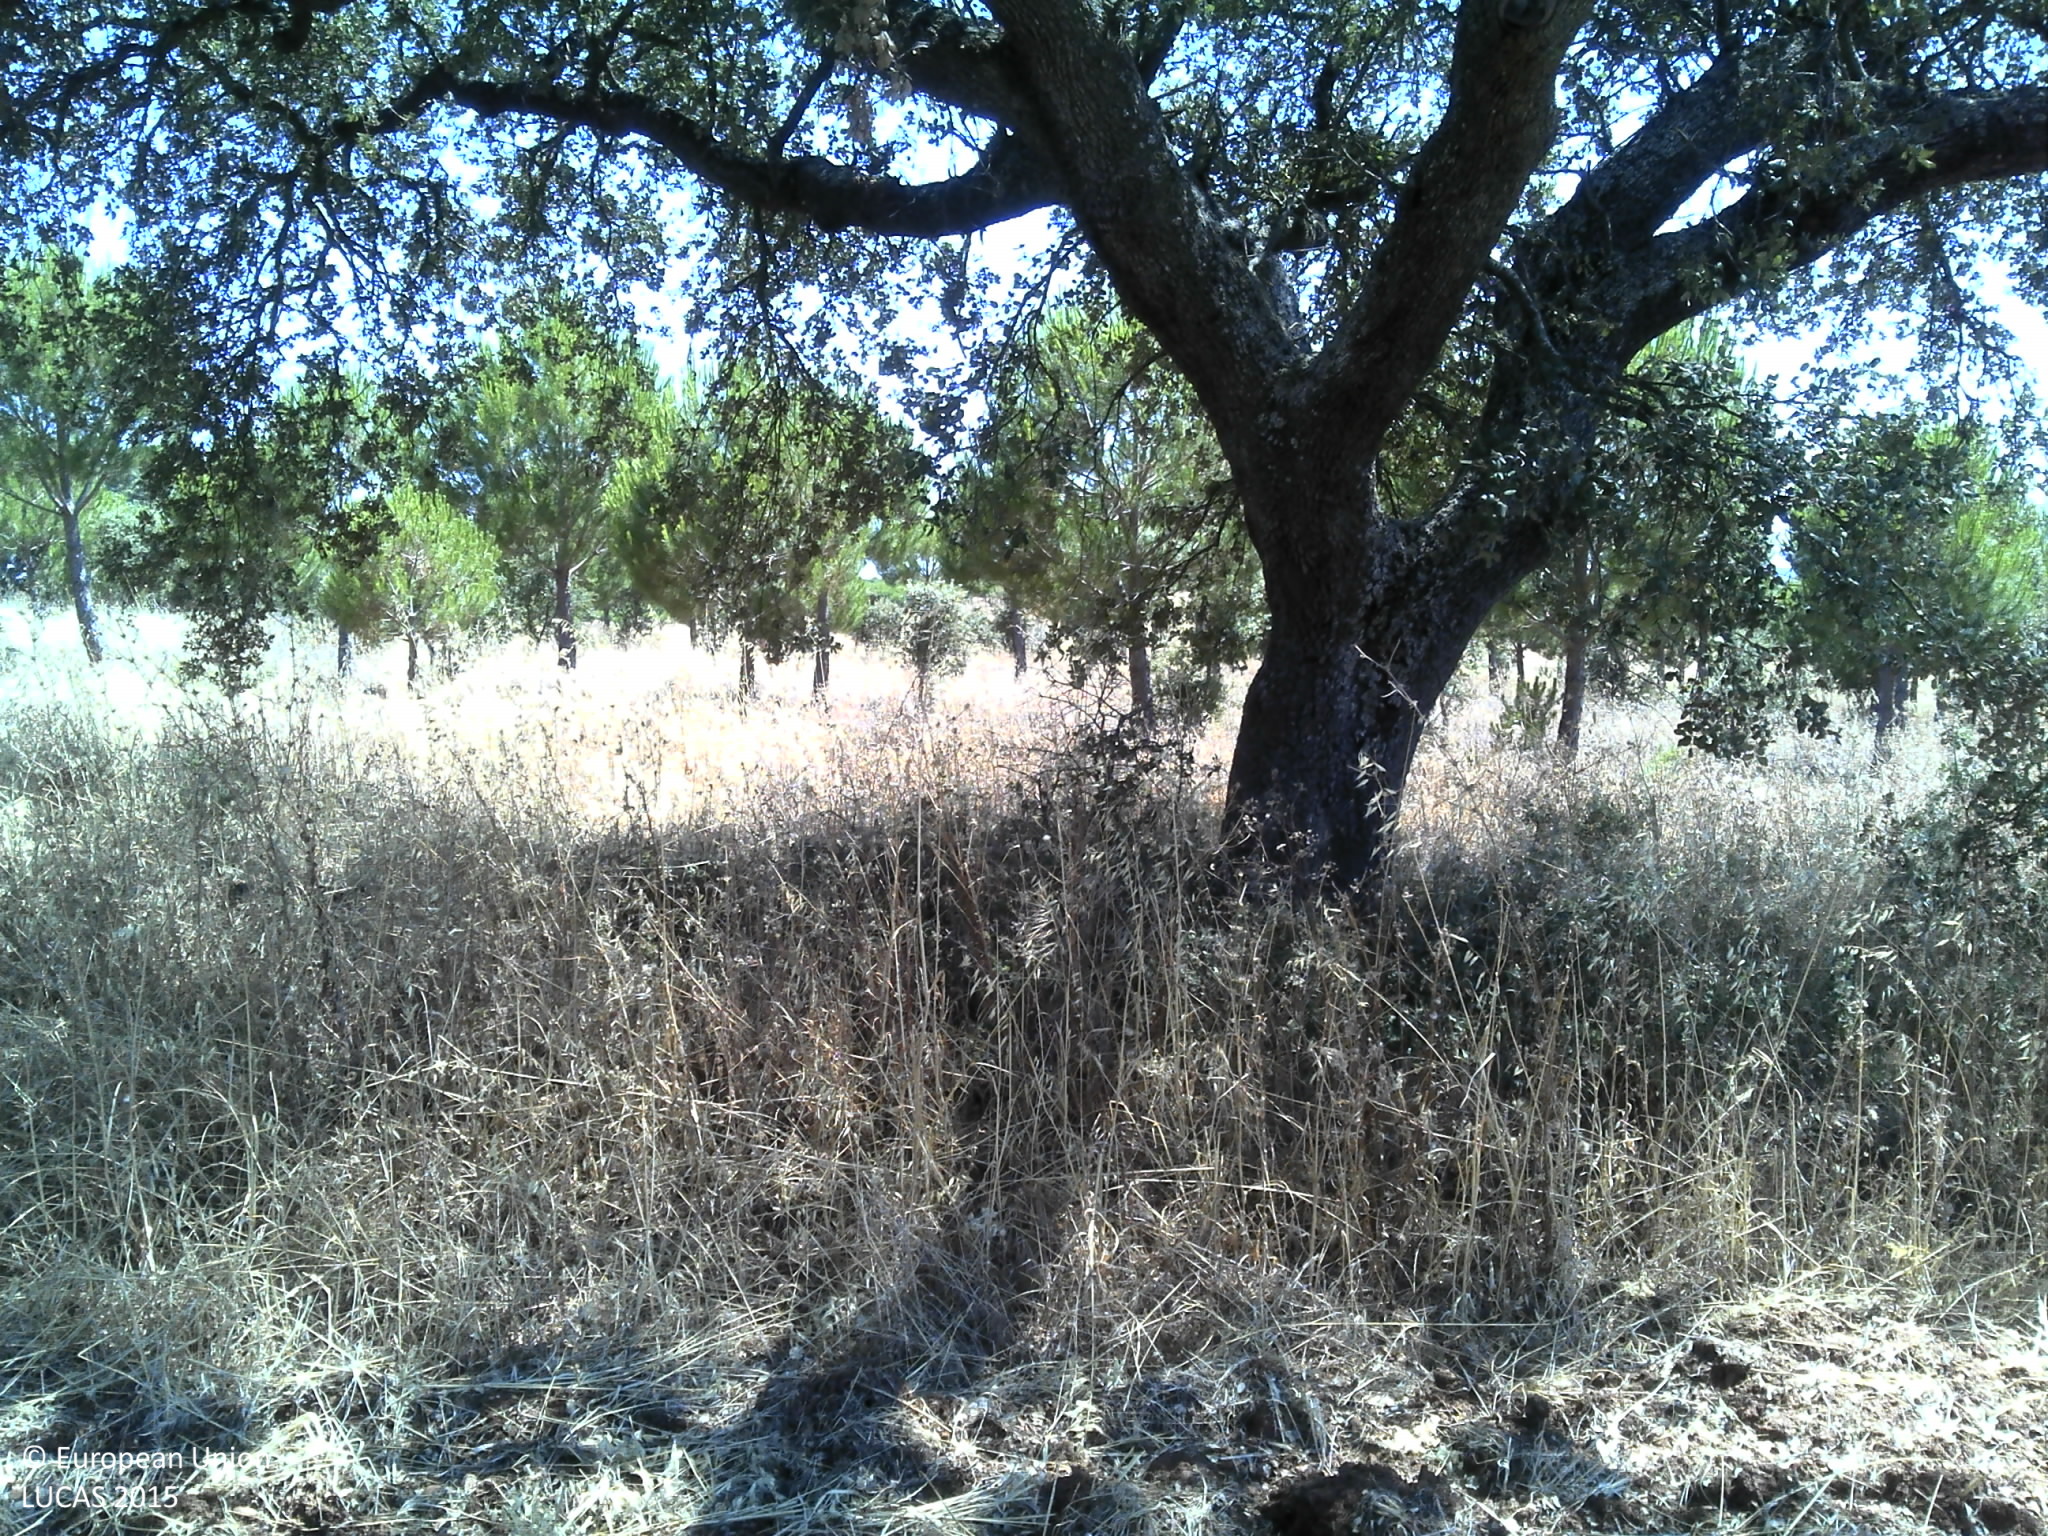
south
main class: Woodland
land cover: Pine dominated mixed woodland
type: coniferous forest of the mediterranean region
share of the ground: 50 - 75 %
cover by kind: coniferous forest trees 50 %, broadleaved forest trees 20 %, herbaceous plants 15 %, unconsolidated bare surface 15 %
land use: Forestry
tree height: < 5 m
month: July
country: PT
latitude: 38.1359
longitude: -7.3488
